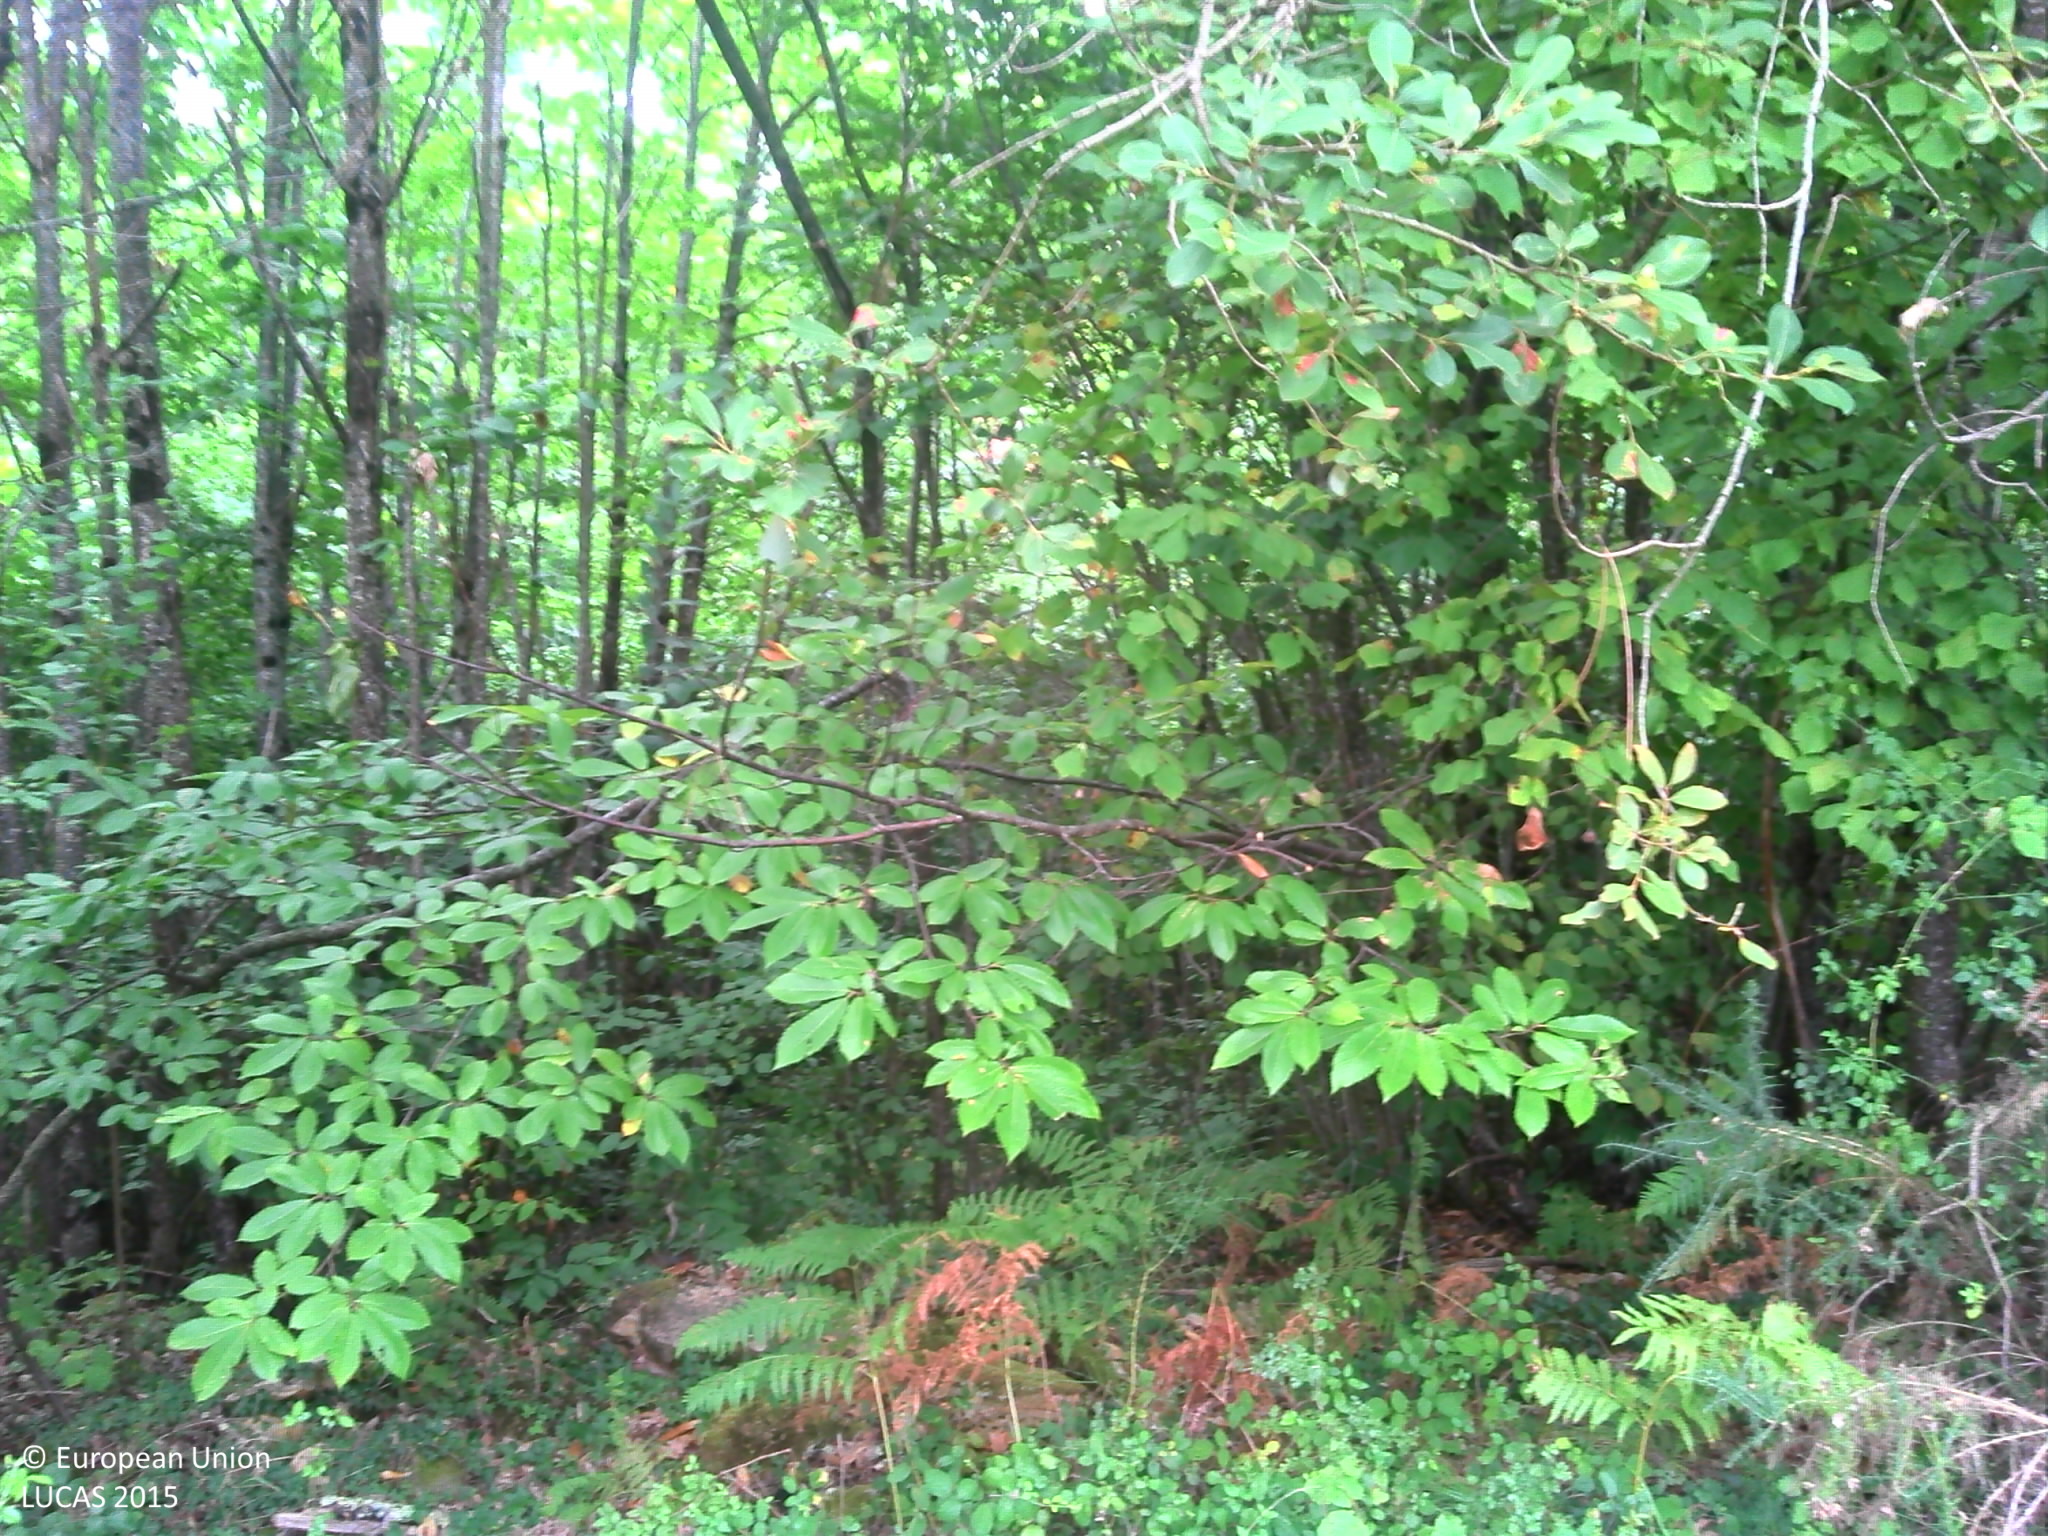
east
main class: Grassland
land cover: Grassland without tree/shrub cover
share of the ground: > 75 %
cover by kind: herbaceous plants 100 %
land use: Agriculture (excluding fallow land and kitchen gardens)
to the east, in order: Grassland without tree/shrub cover; Broadleaved woodland; Rock outcrops; Broadleaved woodland; Ponds and wetlands; Broadleaved woodland; Tracks; Broadleaved woodland; Tracks; Broadleaved woodland; Tracks; Broadleaved woodland; Pine dominated mixed woodland
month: August
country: FR
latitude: 44.5389
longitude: 0.9967
